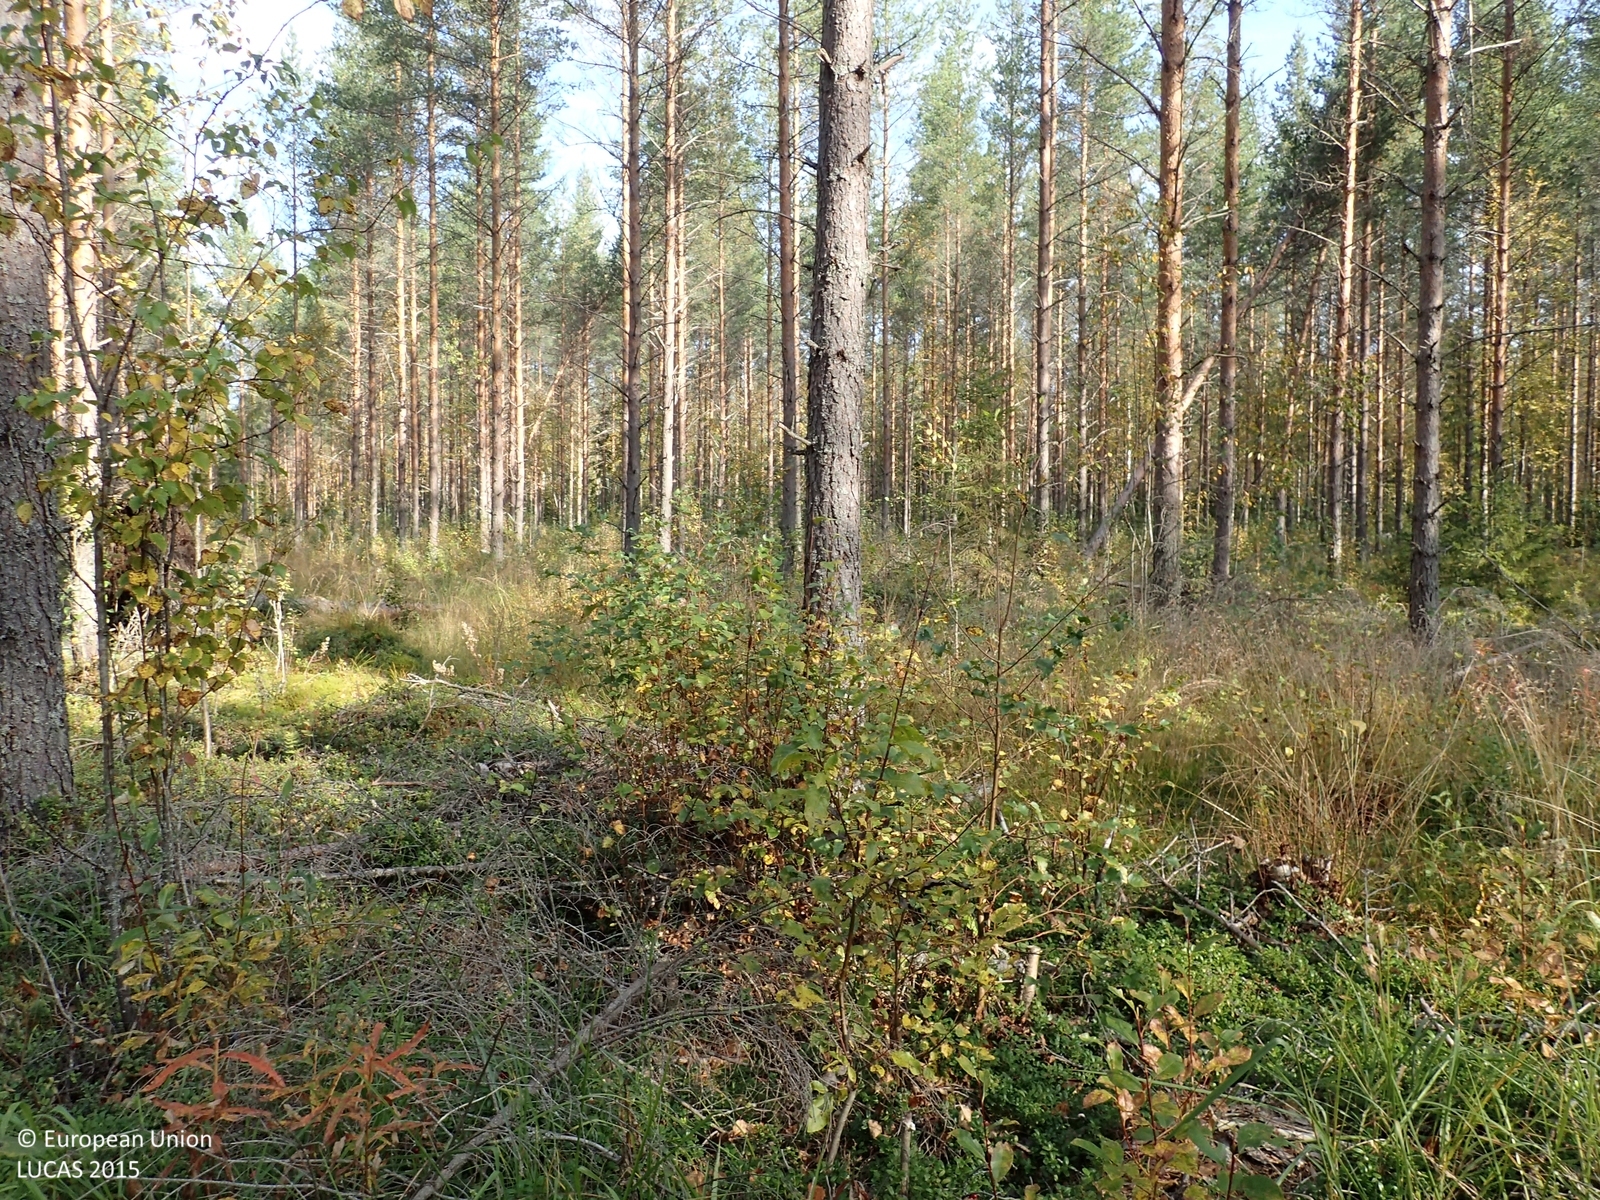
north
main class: Woodland
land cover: Pine dominated mixed woodland
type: boreal forest
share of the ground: > 75 %
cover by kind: coniferous forest trees 55 %, broadleaved forest trees 20 %, shrubs 15 %, herbaceous plants 5 %, lichens and mosses 5 %
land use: Forestry
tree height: > 5 m
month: September
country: FI
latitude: 62.9910
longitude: 25.6033
